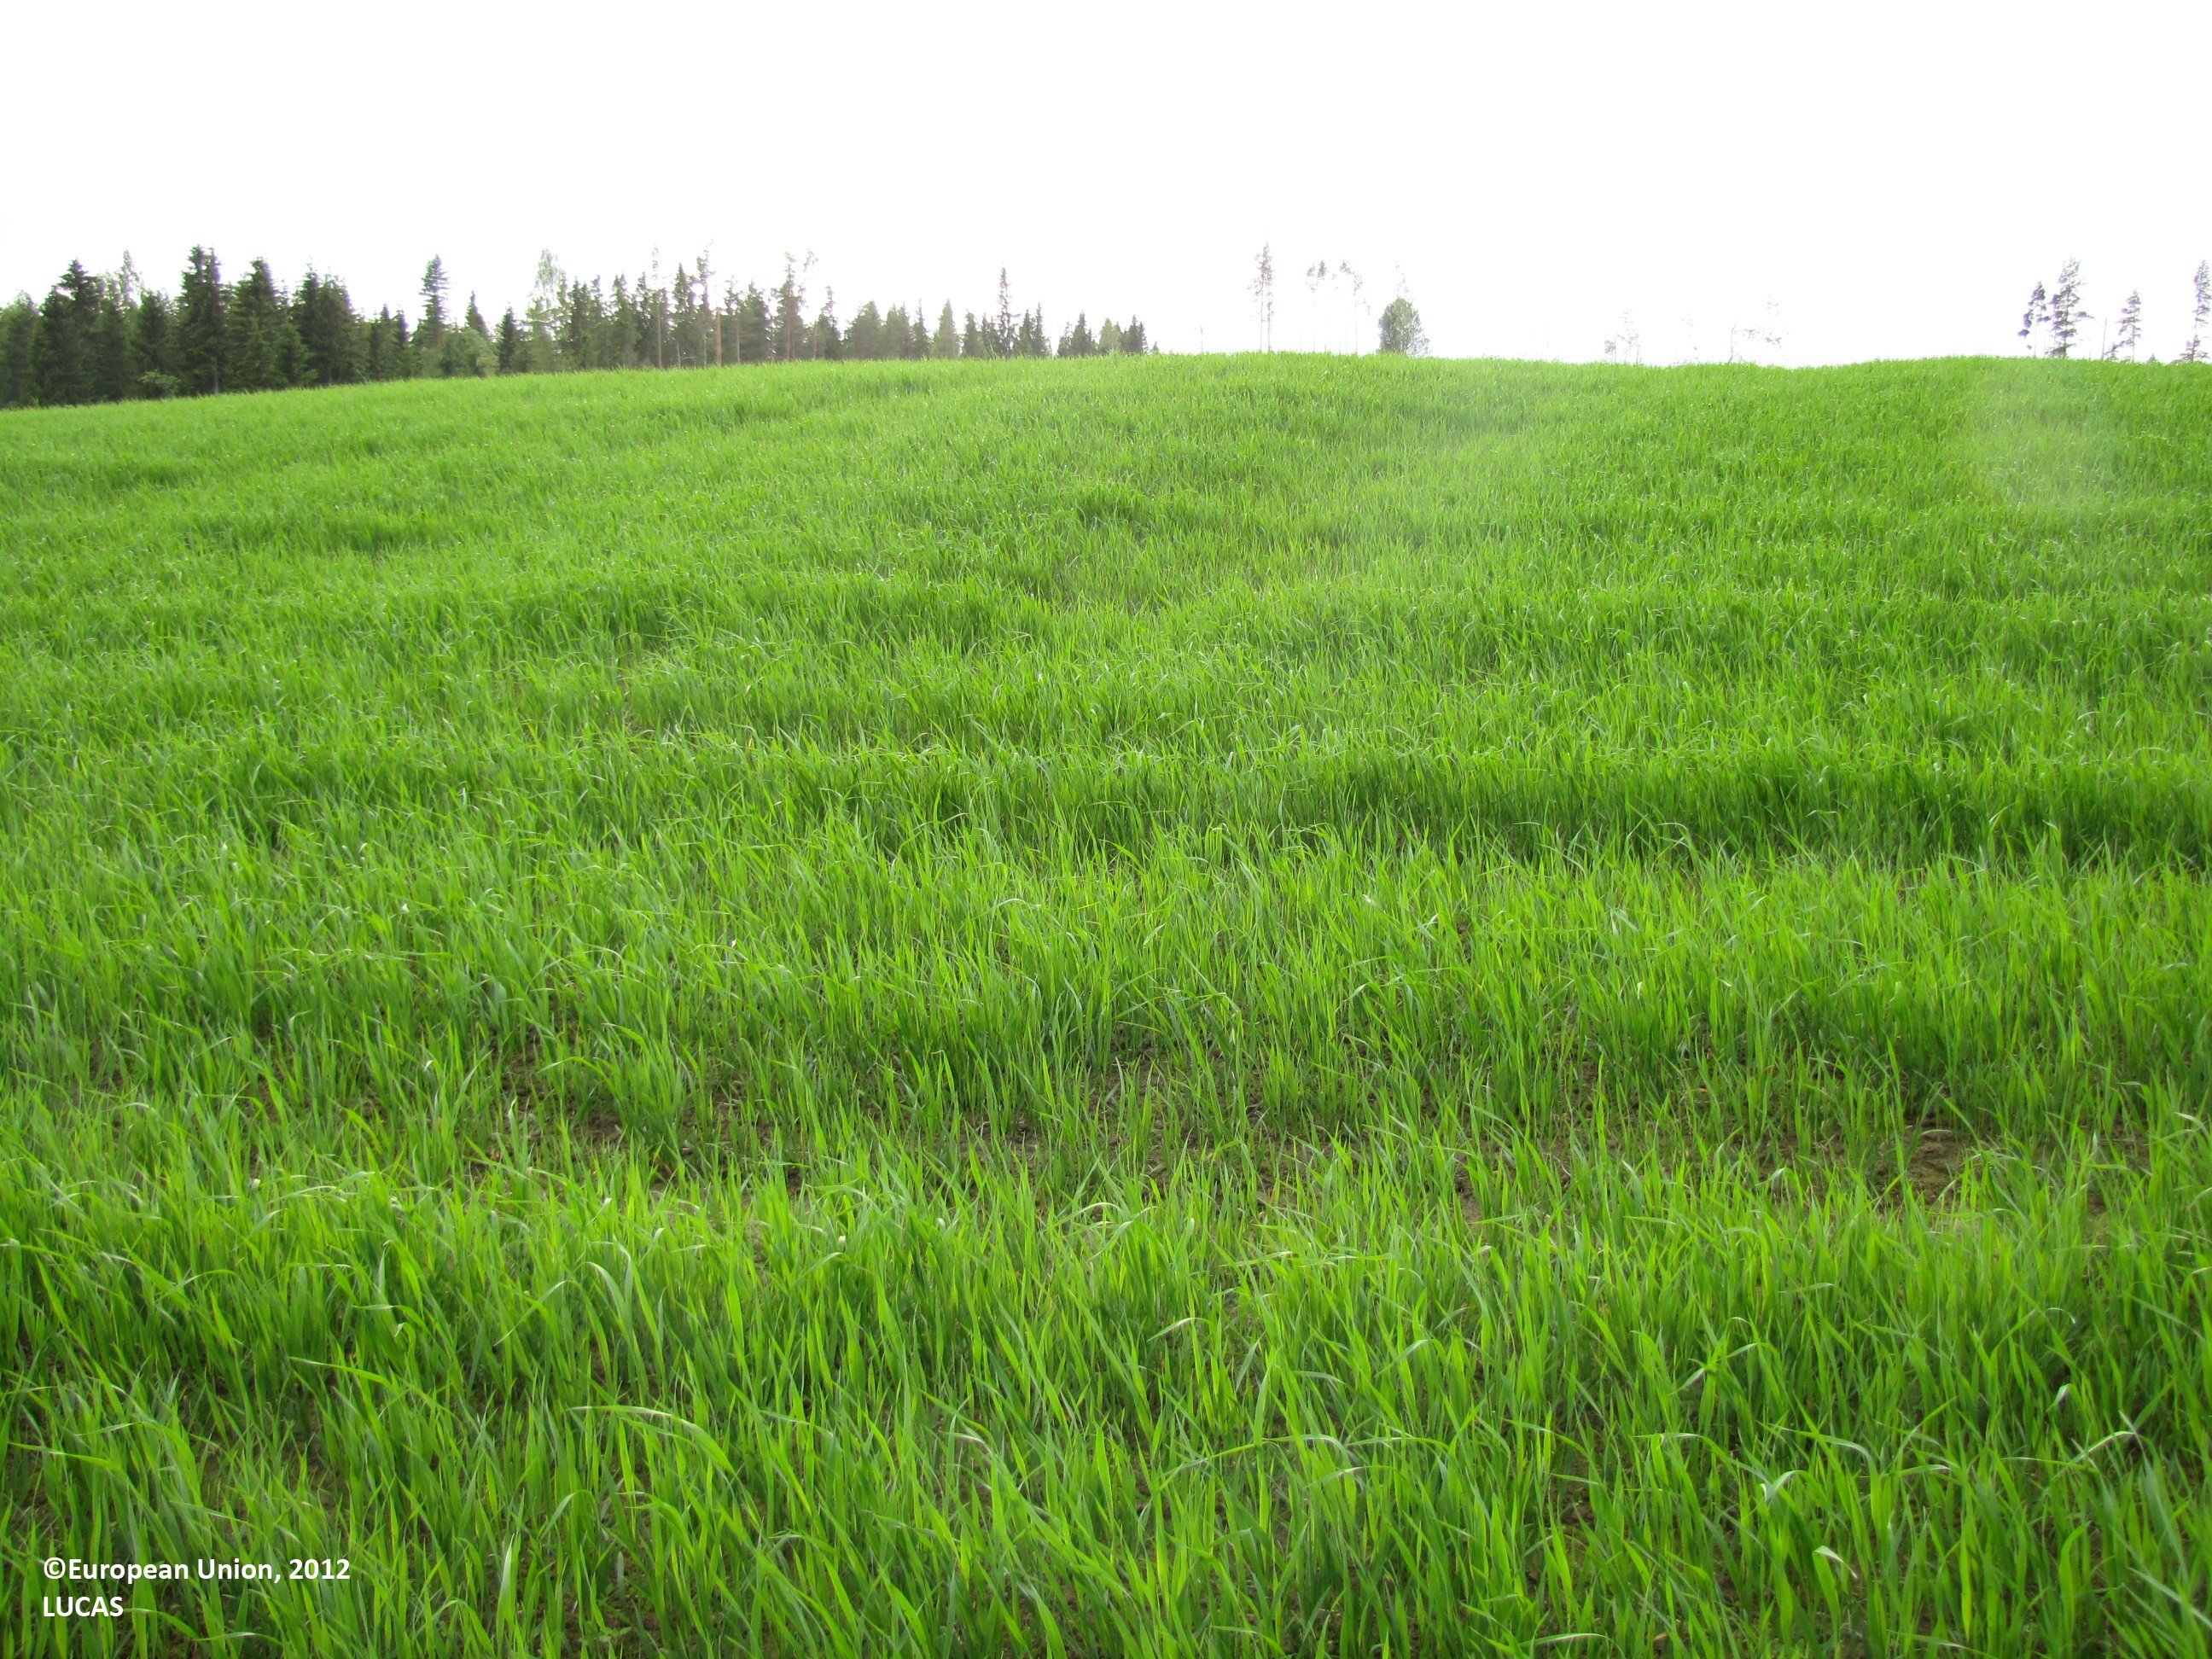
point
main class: Cropland
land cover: Oats
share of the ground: 50 - 75 %
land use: Agriculture (excluding fallow land and kitchen gardens)
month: June
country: FI
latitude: 61.7993
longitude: 24.4547
